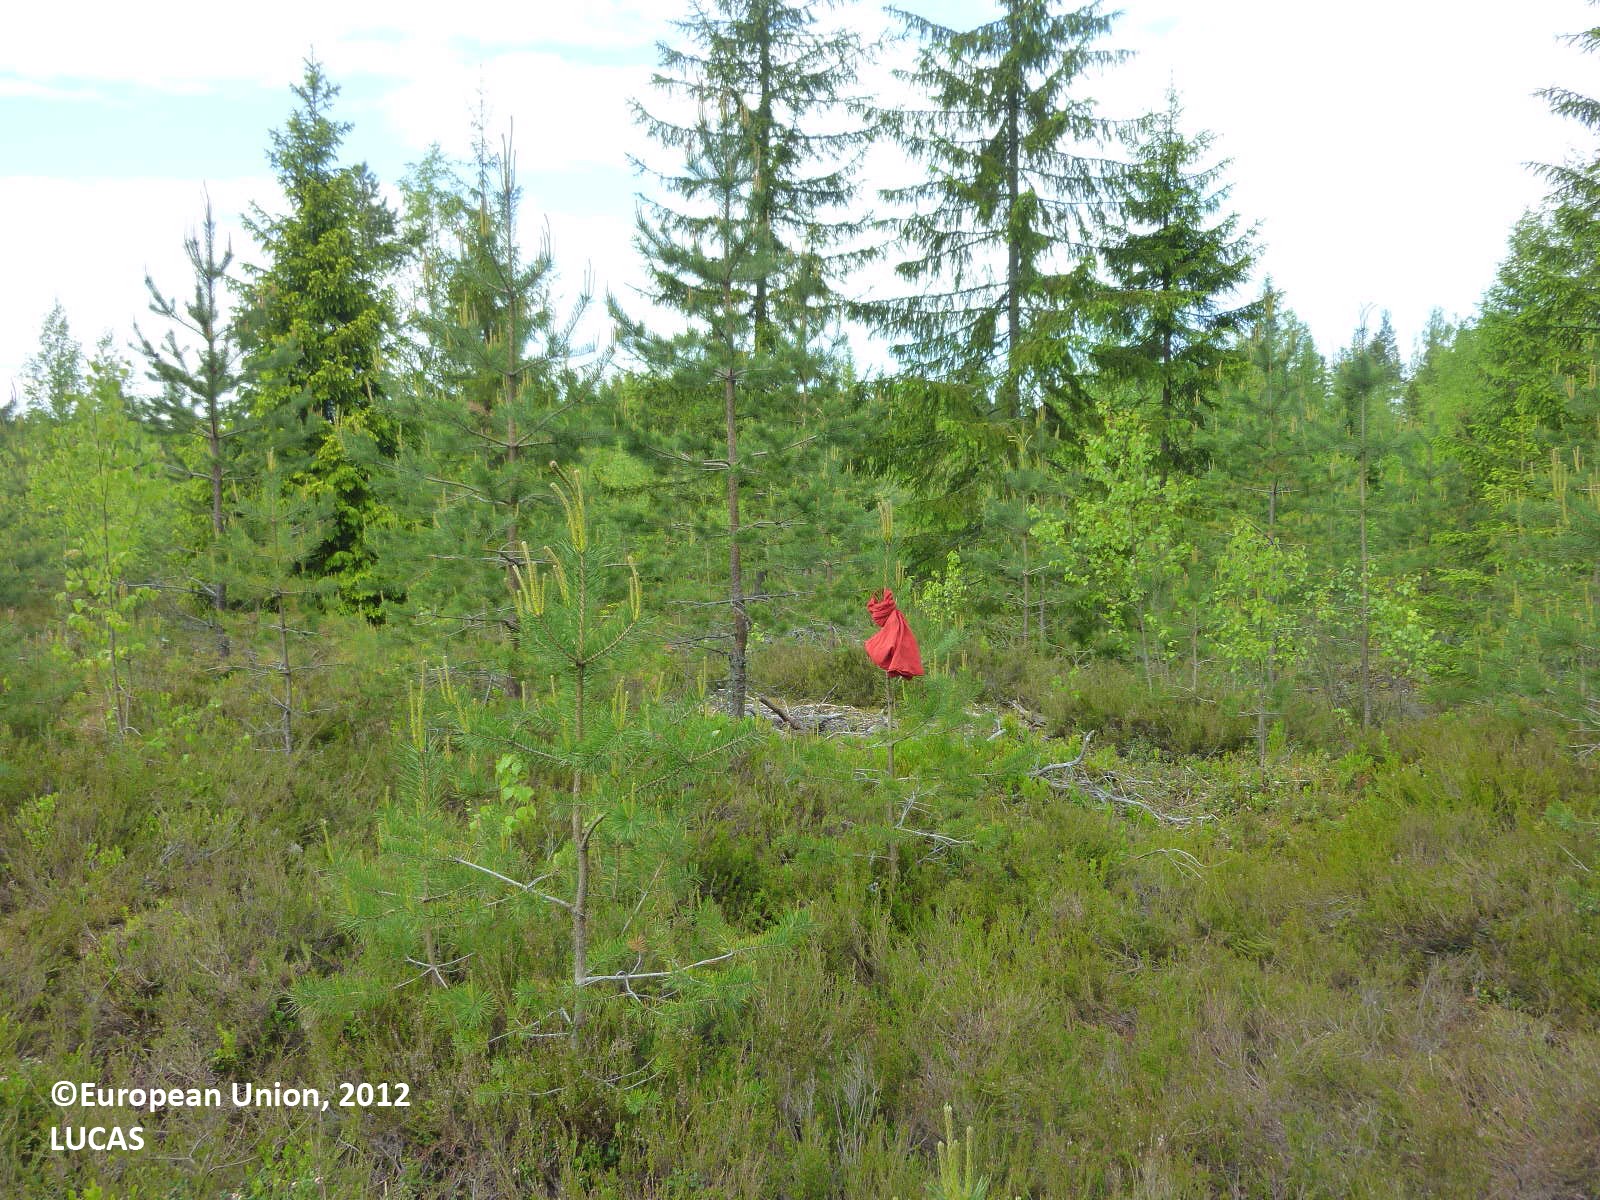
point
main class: Woodland
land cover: Pine dominated coniferous woodland
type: boreal forest
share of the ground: 25 - 50 %
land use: Forestry
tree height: > 5 m
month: June
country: FI
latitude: 60.5850
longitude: 22.7597
